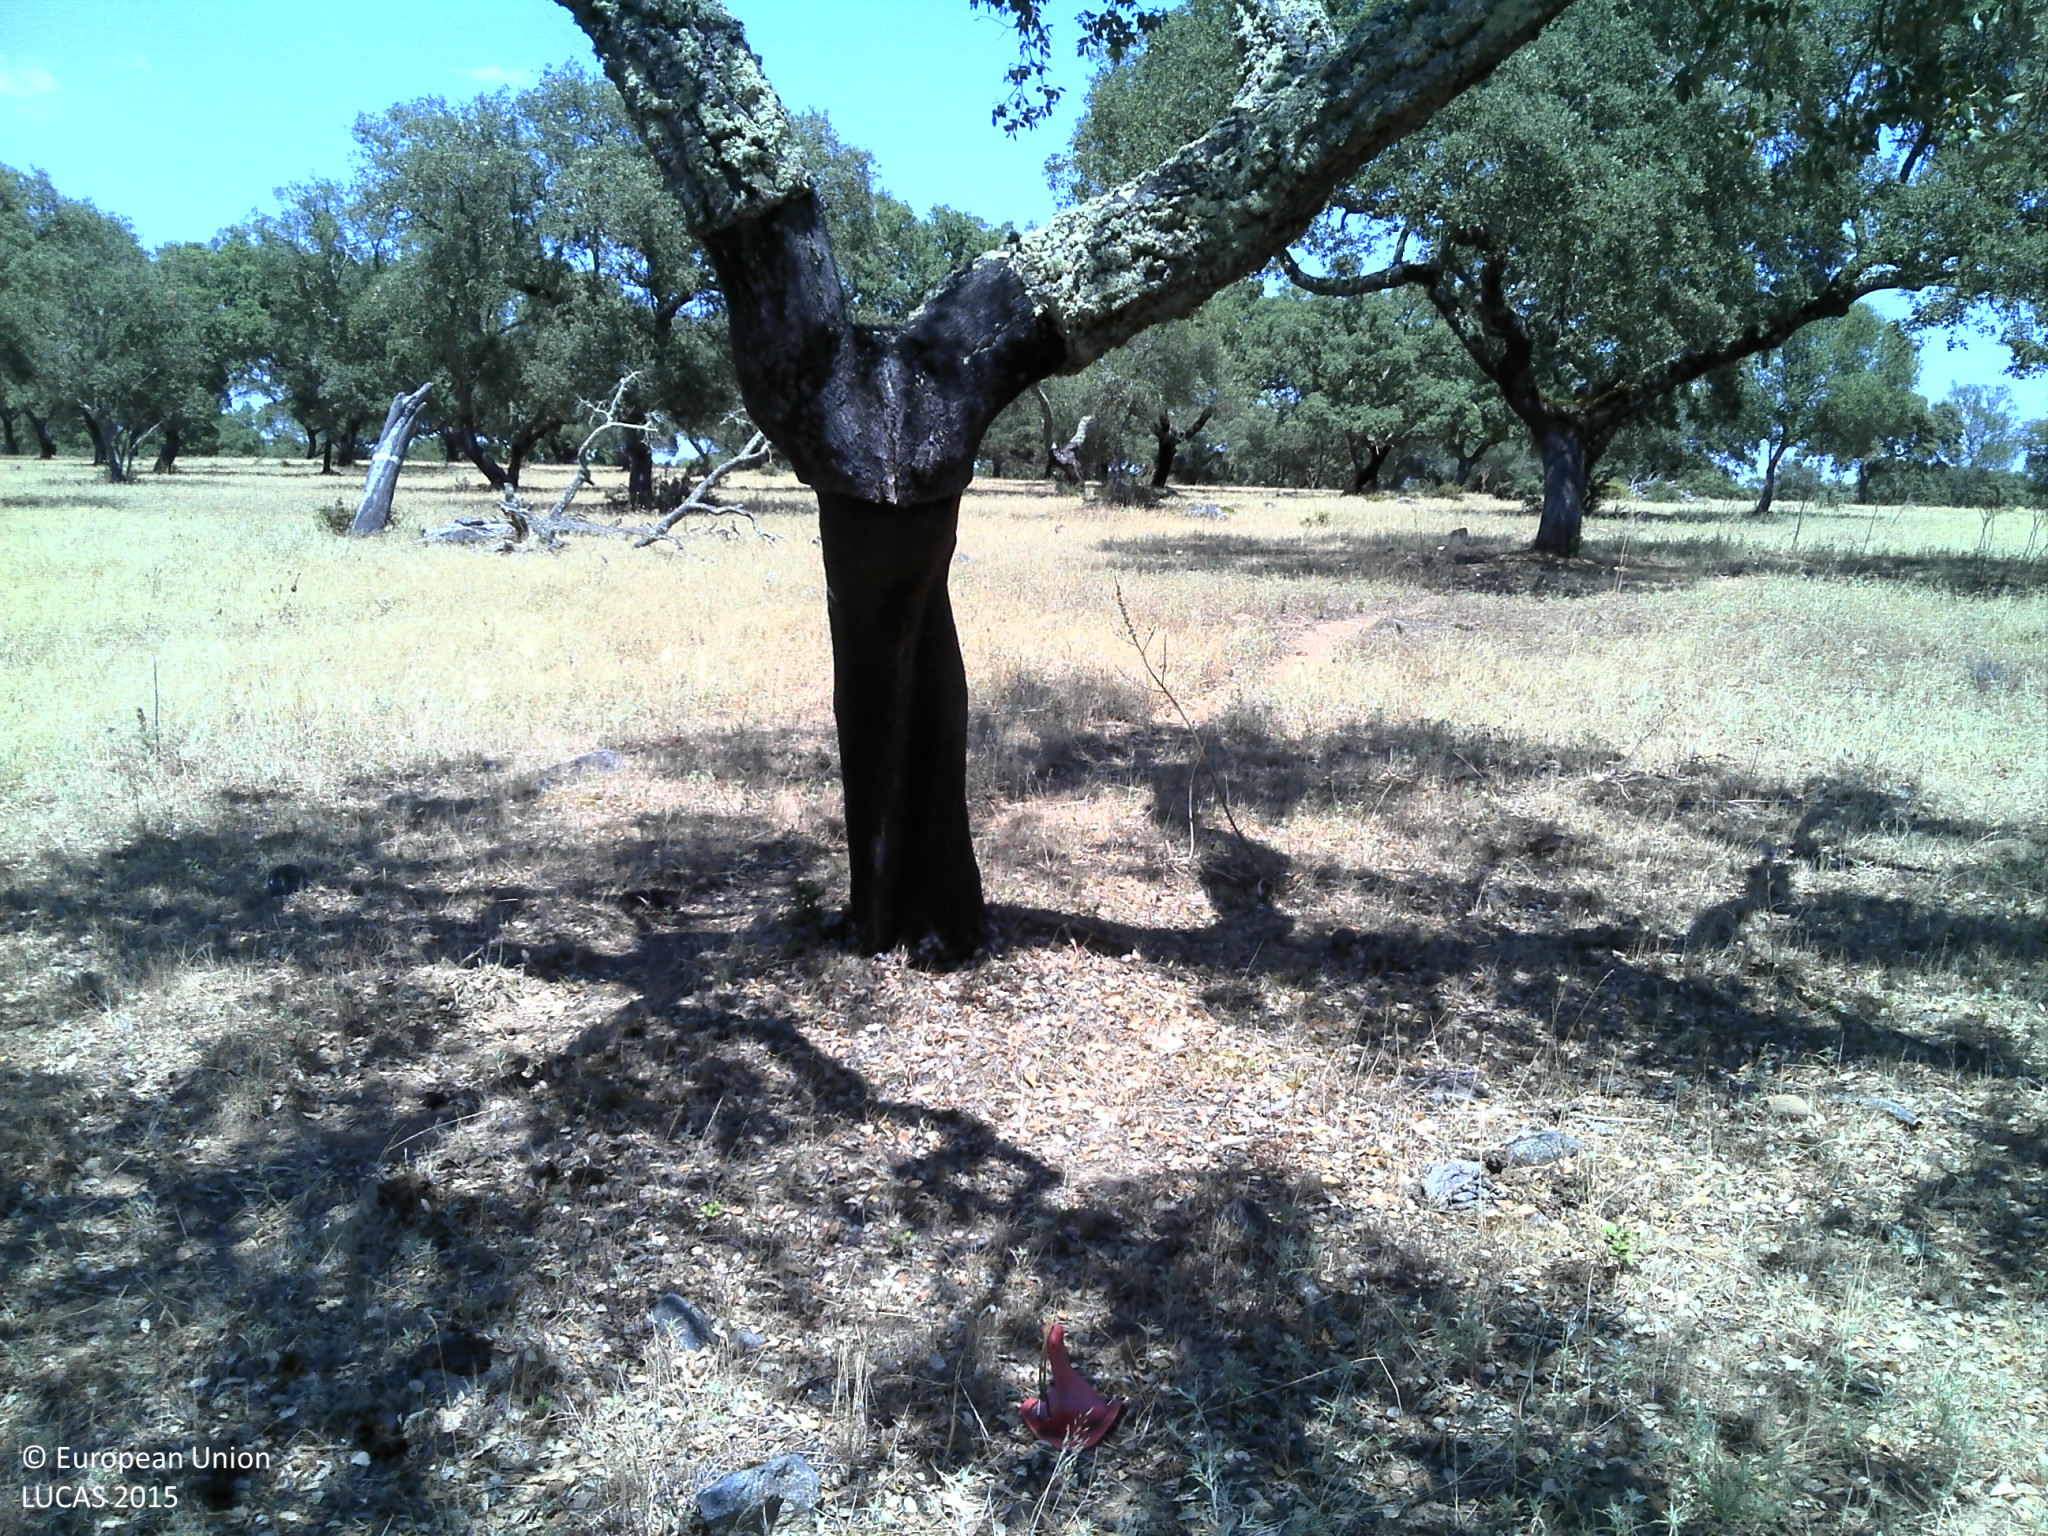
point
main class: Woodland
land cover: Broadleaved woodland
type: broadleaved evergreen forest
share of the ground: 10 - 25 %
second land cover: Grassland without tree/shrub cover
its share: 25 - 50 %
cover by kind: unconsolidated bare surface 50 %, broadleaved forest trees 25 %, herbaceous plants 25 %
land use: Forestry
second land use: Agriculture (excluding fallow land and kitchen gardens)
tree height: > 5 m
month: June
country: PT
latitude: 38.3537
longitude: -8.1560
